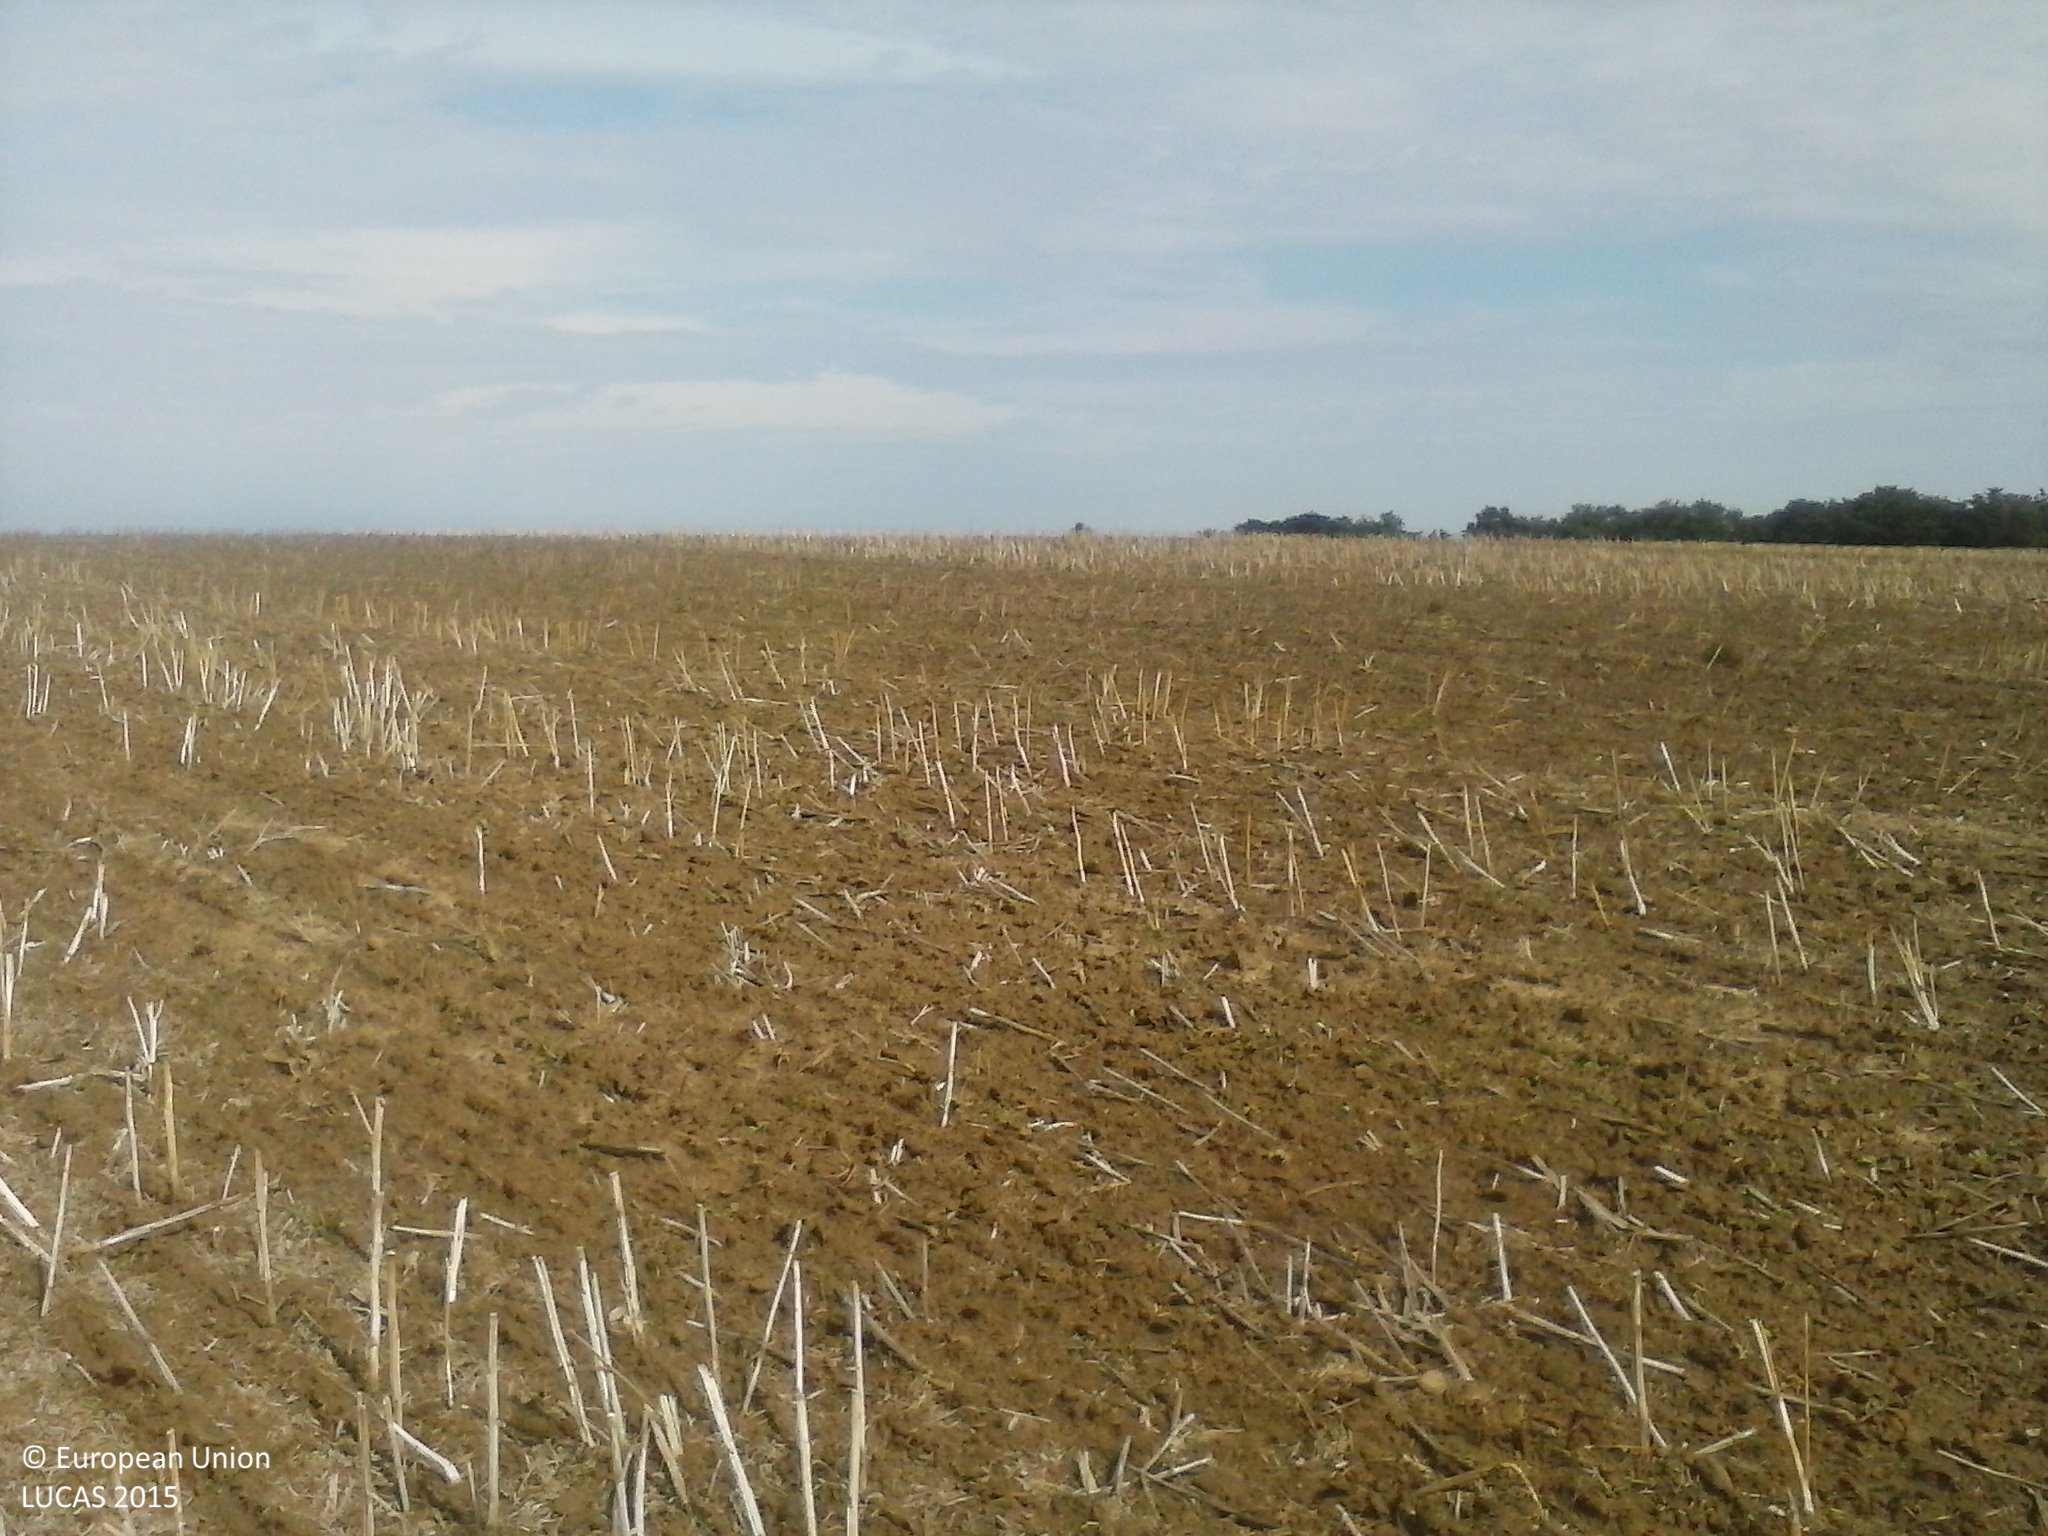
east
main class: Cropland
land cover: Rape and turnip rape
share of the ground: < 10 %
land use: Agriculture (excluding fallow land and kitchen gardens)
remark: Harvested field
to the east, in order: Rape and turnip rape
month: July
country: HU
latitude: 46.1061
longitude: 17.2344
